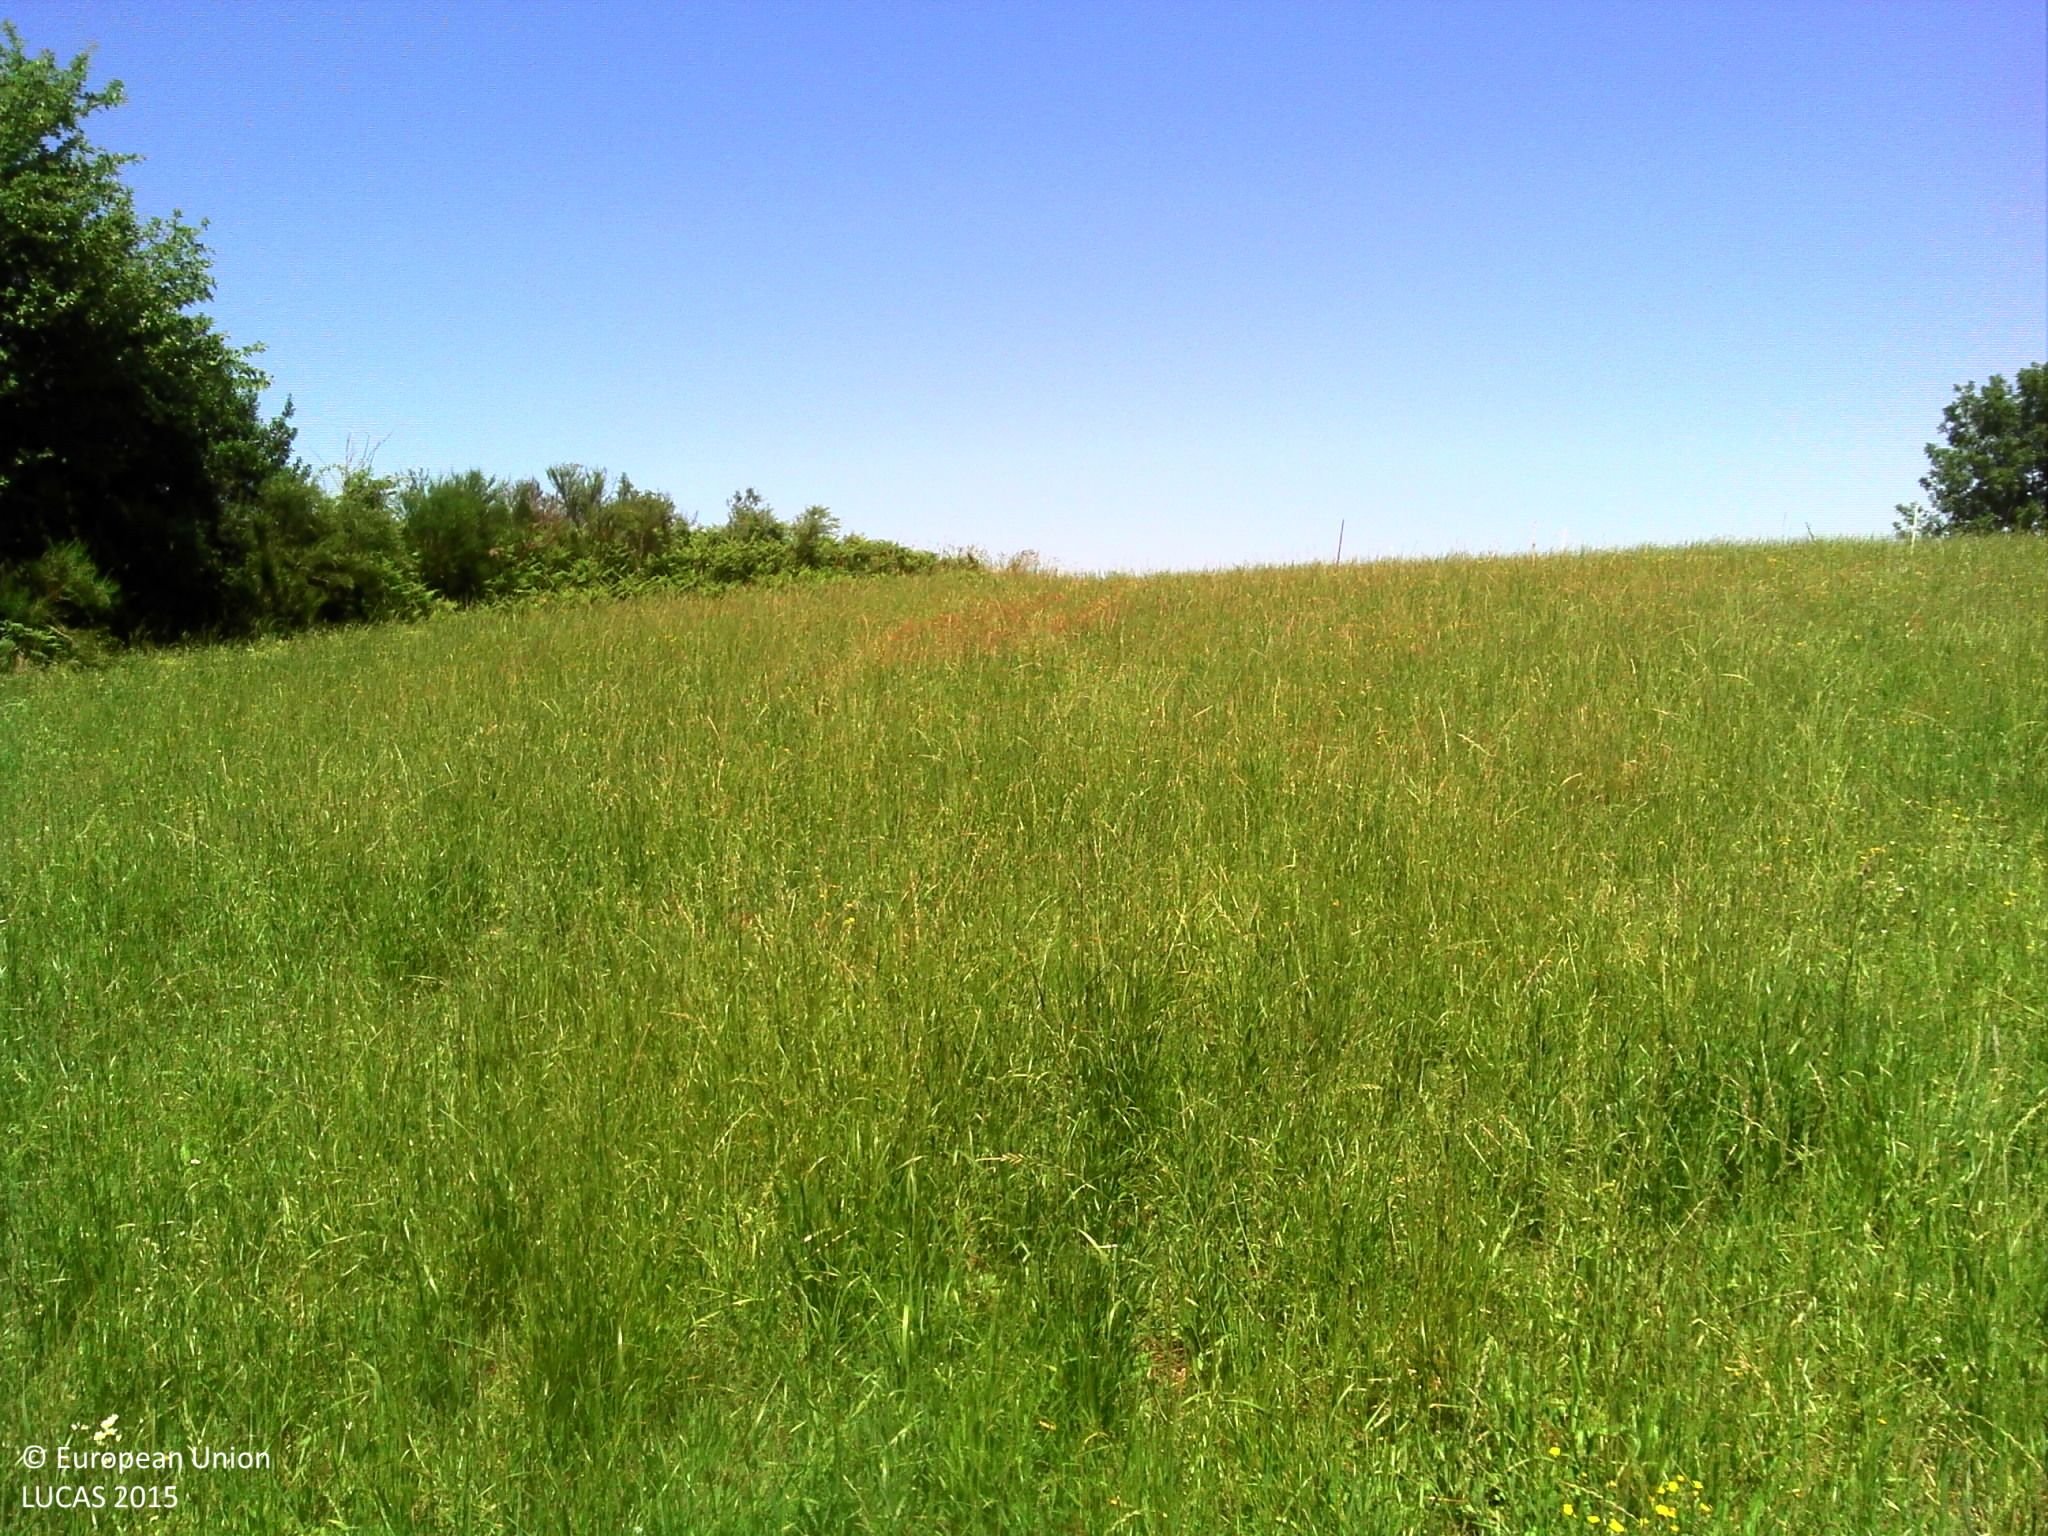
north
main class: Grassland
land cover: Grassland without tree/shrub cover
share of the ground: > 75 %
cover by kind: herbaceous plants 100 %
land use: Agriculture (excluding fallow land and kitchen gardens)
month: June
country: FR
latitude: 43.7219
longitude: 2.5708
